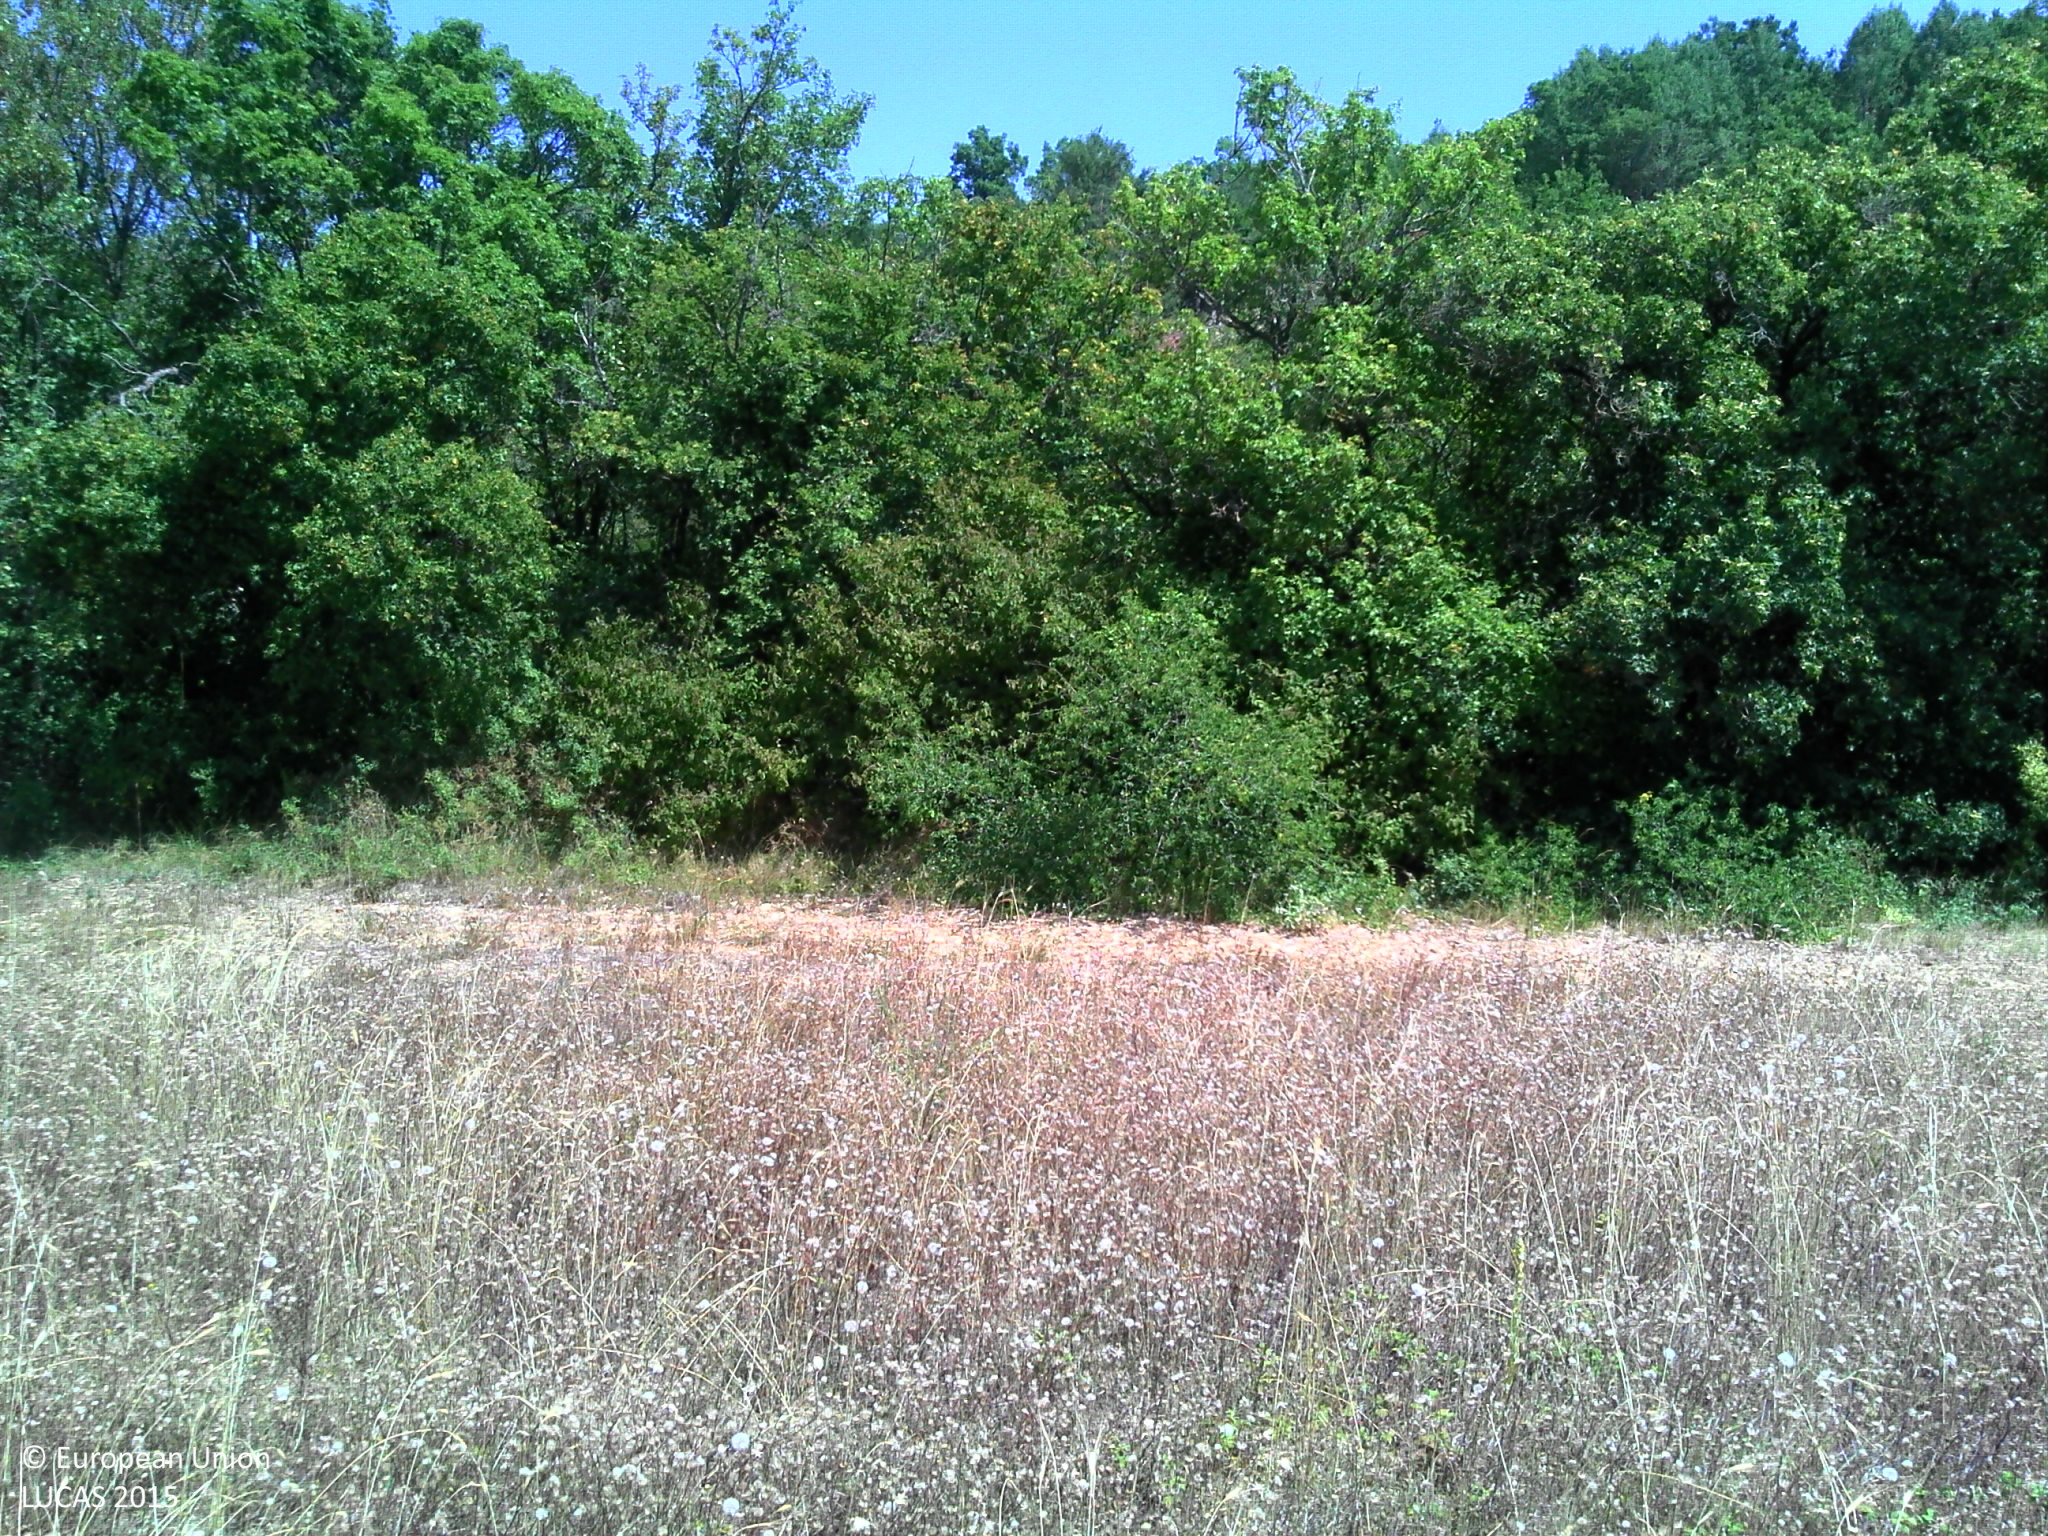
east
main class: Cropland
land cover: Barley
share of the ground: > 75 %
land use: Agriculture (excluding fallow land and kitchen gardens)
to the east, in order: Barley; Broadleaved woodland; Rocks and stones; Broadleaved woodland; Tracks; Broadleaved woodland; Shrubland with sparse tree cover; Permanent industrial crops
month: July
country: FR
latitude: 44.0882
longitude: 5.4495
